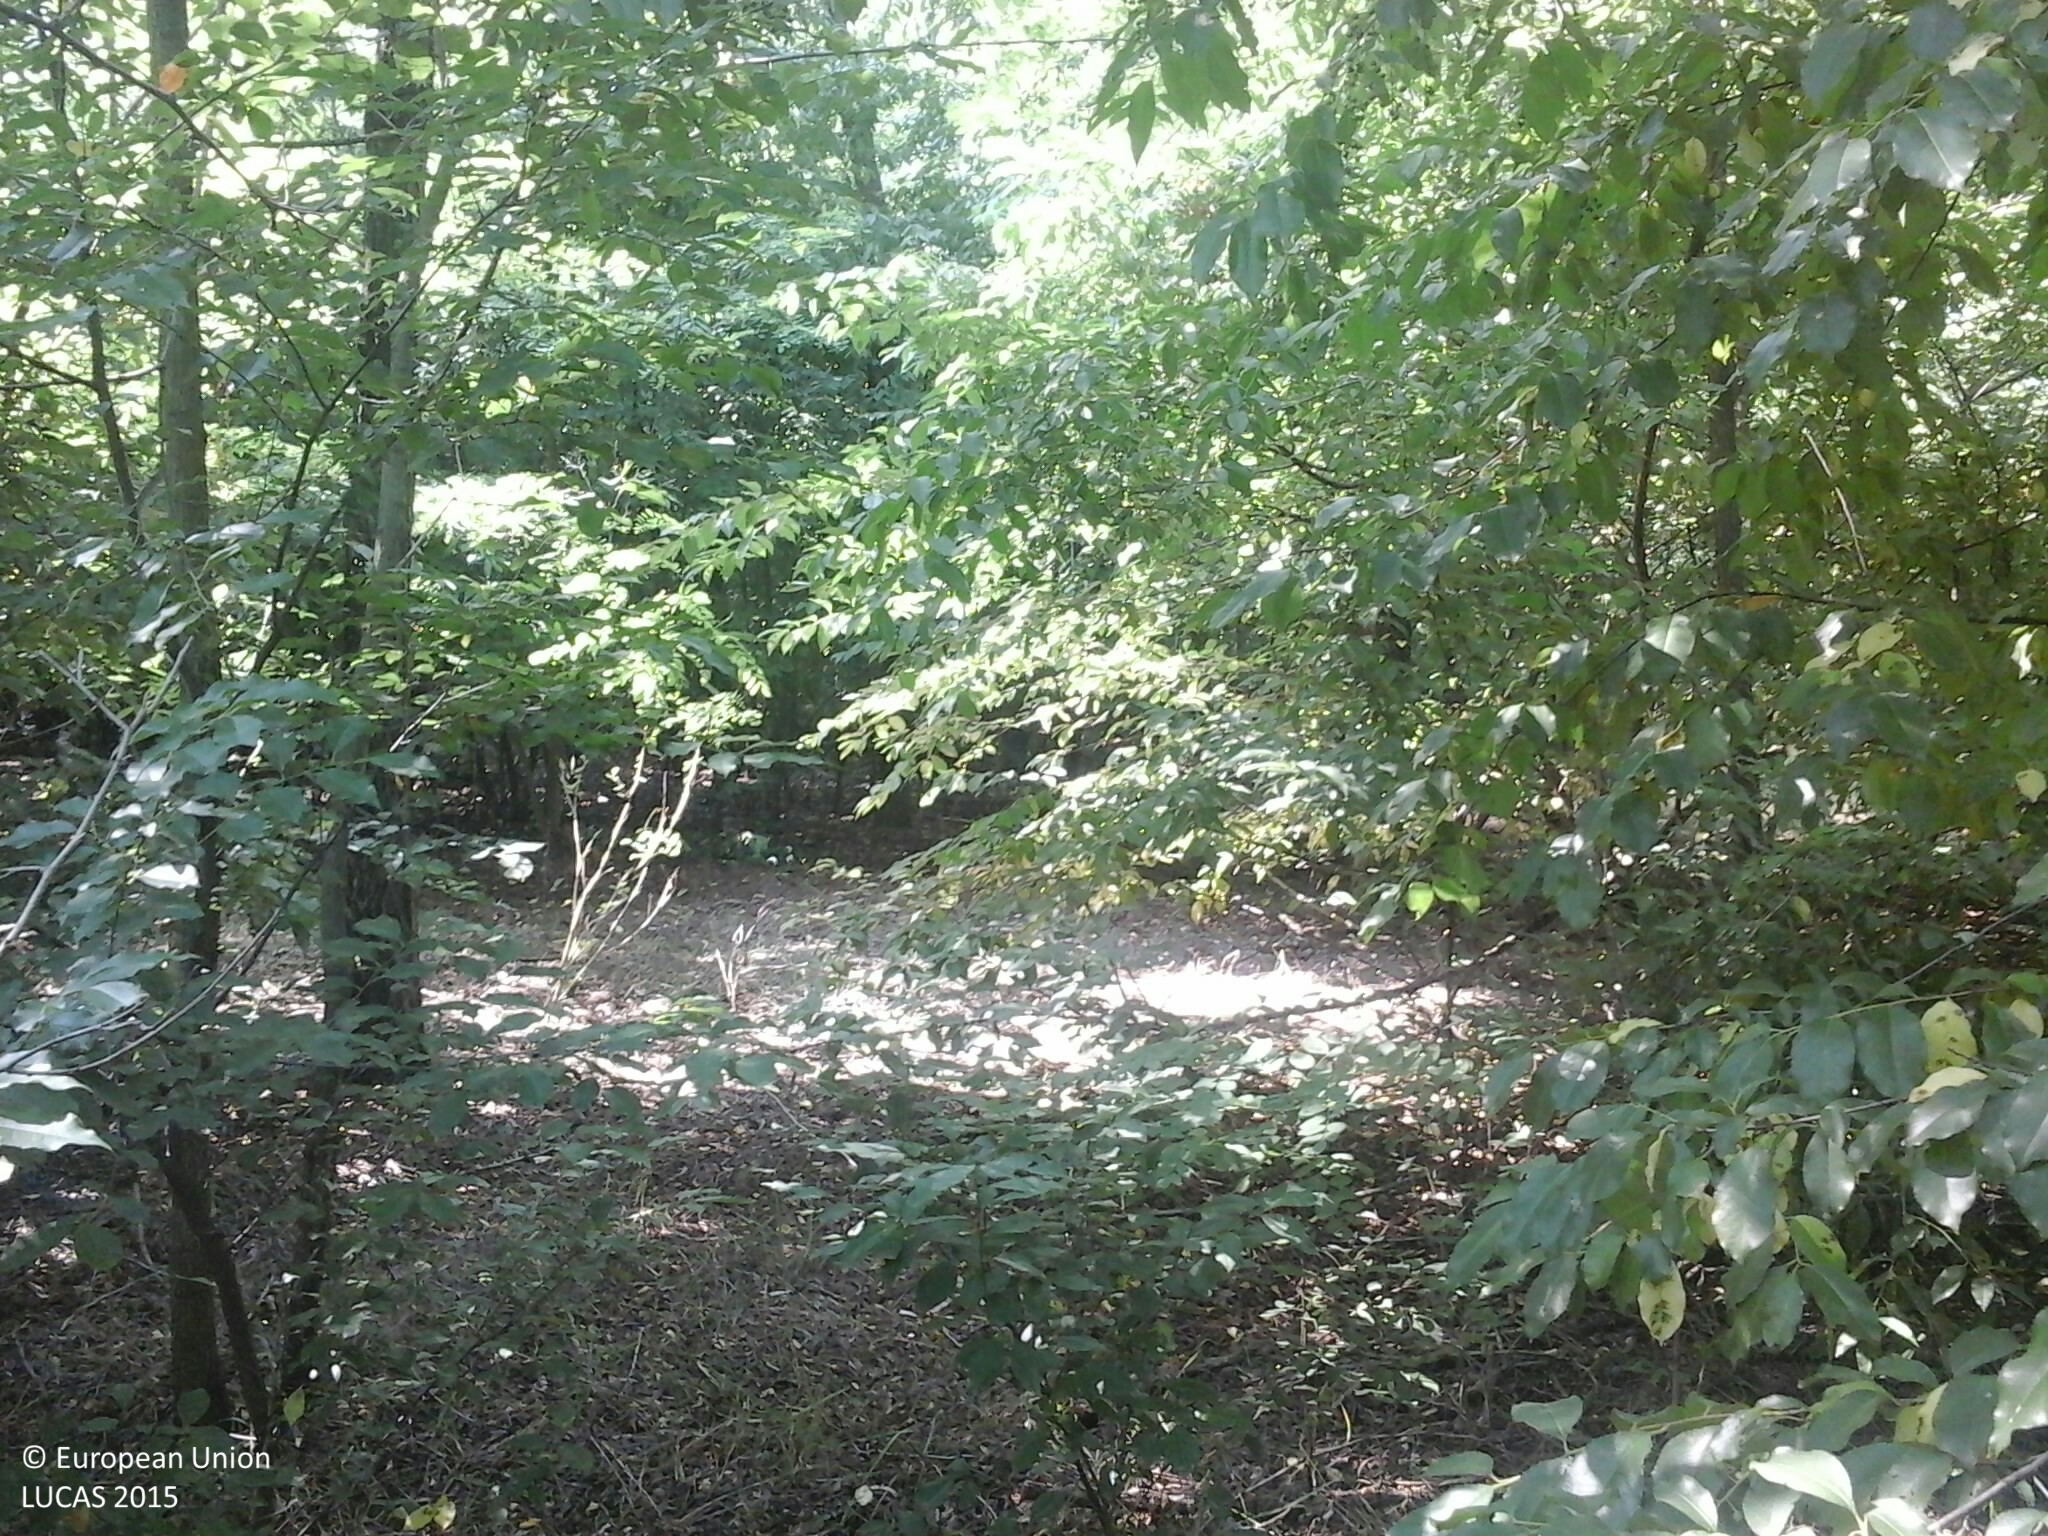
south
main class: Woodland
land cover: Broadleaved woodland
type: mesophytic deciduous forest
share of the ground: 25 - 50 %
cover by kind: broadleaved forest trees 95 %, herbaceous plants 5 %
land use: Forestry
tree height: > 5 m
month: July
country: HU
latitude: 47.6892
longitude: 21.8662
